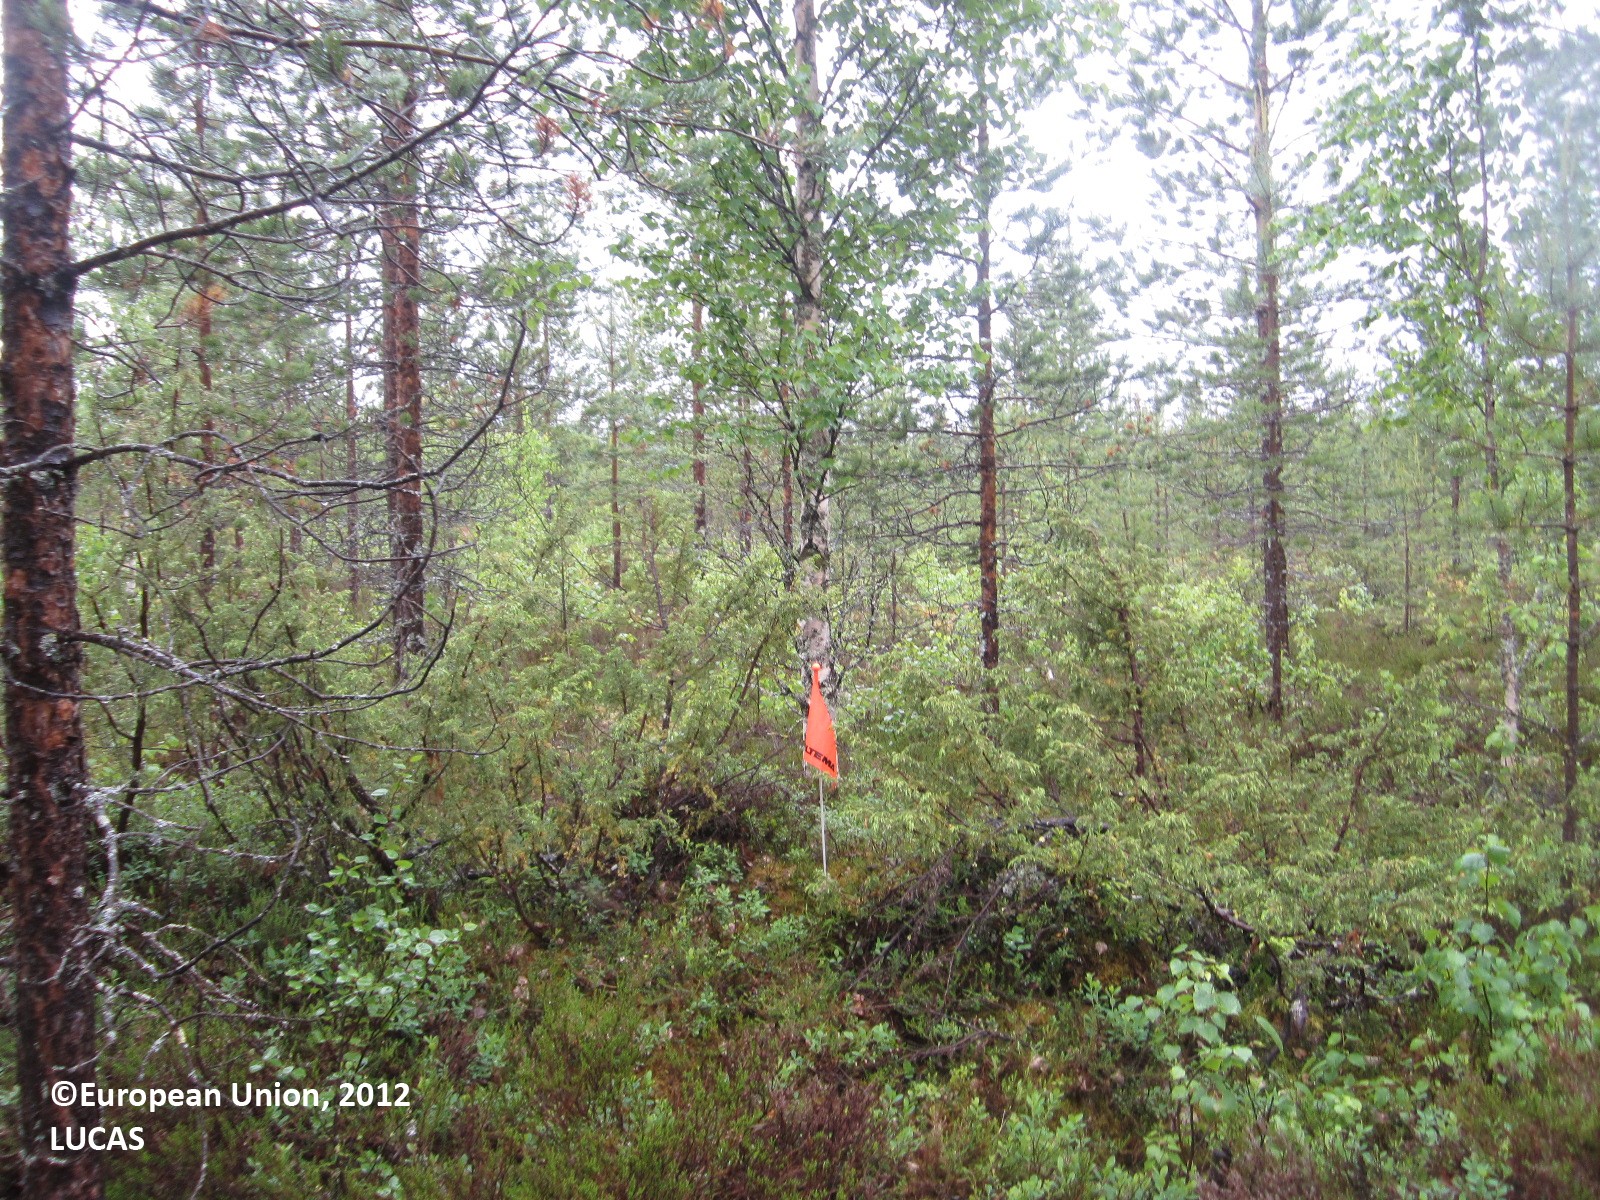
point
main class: Woodland
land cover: Pine dominated coniferous woodland
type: boreal forest
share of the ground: 50 - 75 %
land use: Forestry
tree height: > 5 m
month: June
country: FI
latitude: 64.6626
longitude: 29.2380
